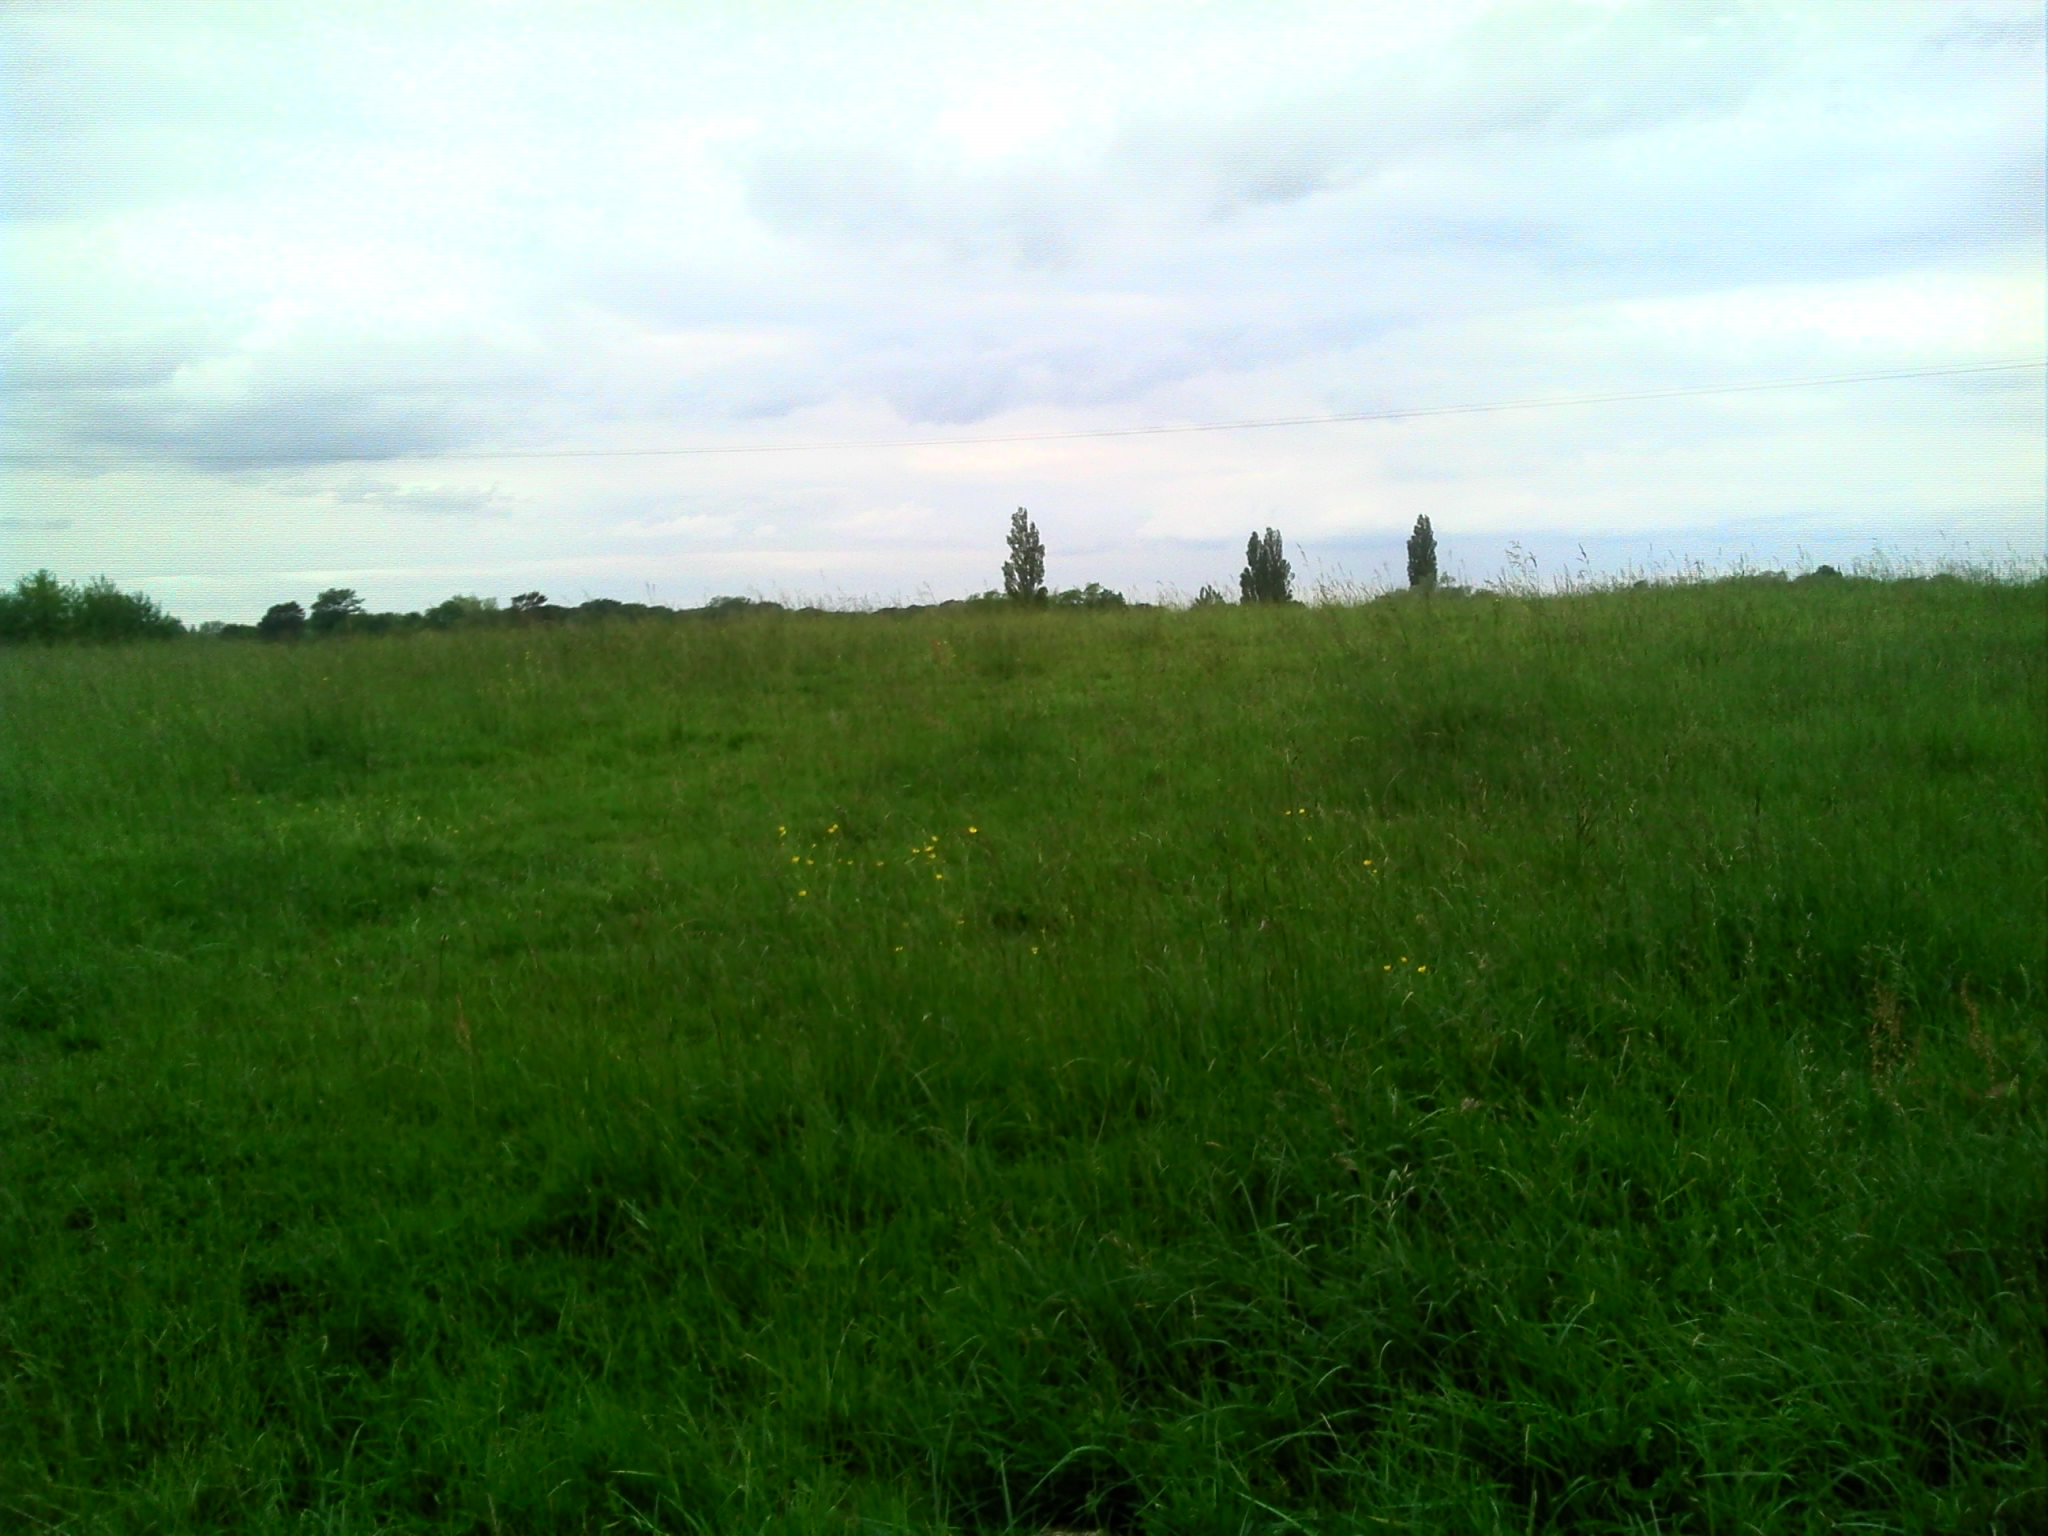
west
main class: Grassland
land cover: Grassland without tree/shrub cover
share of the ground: > 75 %
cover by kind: herbaceous plants 100 %
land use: Agriculture (excluding fallow land and kitchen gardens)
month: May
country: FR
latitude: 46.5386
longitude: 5.3473
